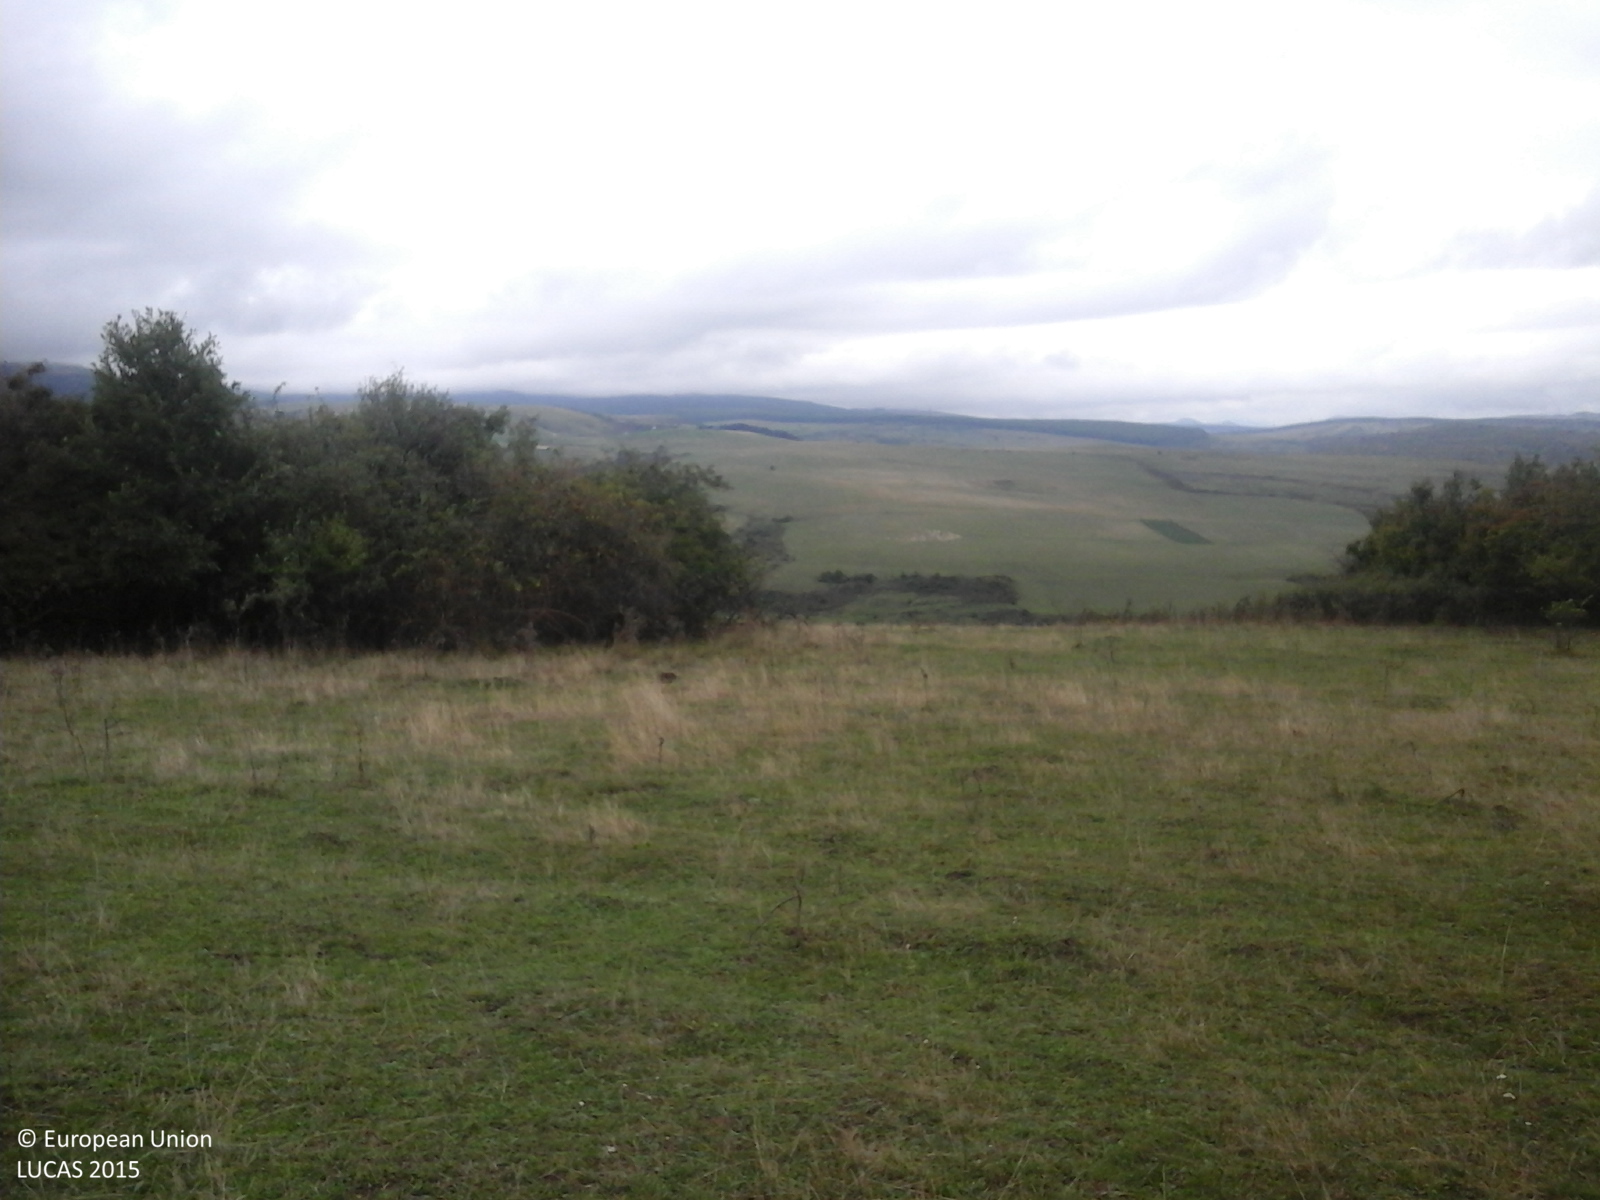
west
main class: Grassland
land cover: Grassland with sparse tree/shrub cover
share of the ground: > 75 %
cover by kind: herbaceous plants 85 %, shrubs 10 %, broadleaved forest trees 5 %
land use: Agriculture (excluding fallow land and kitchen gardens)
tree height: < 5 m
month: September
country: RO
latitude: 45.8443
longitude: 23.7293
